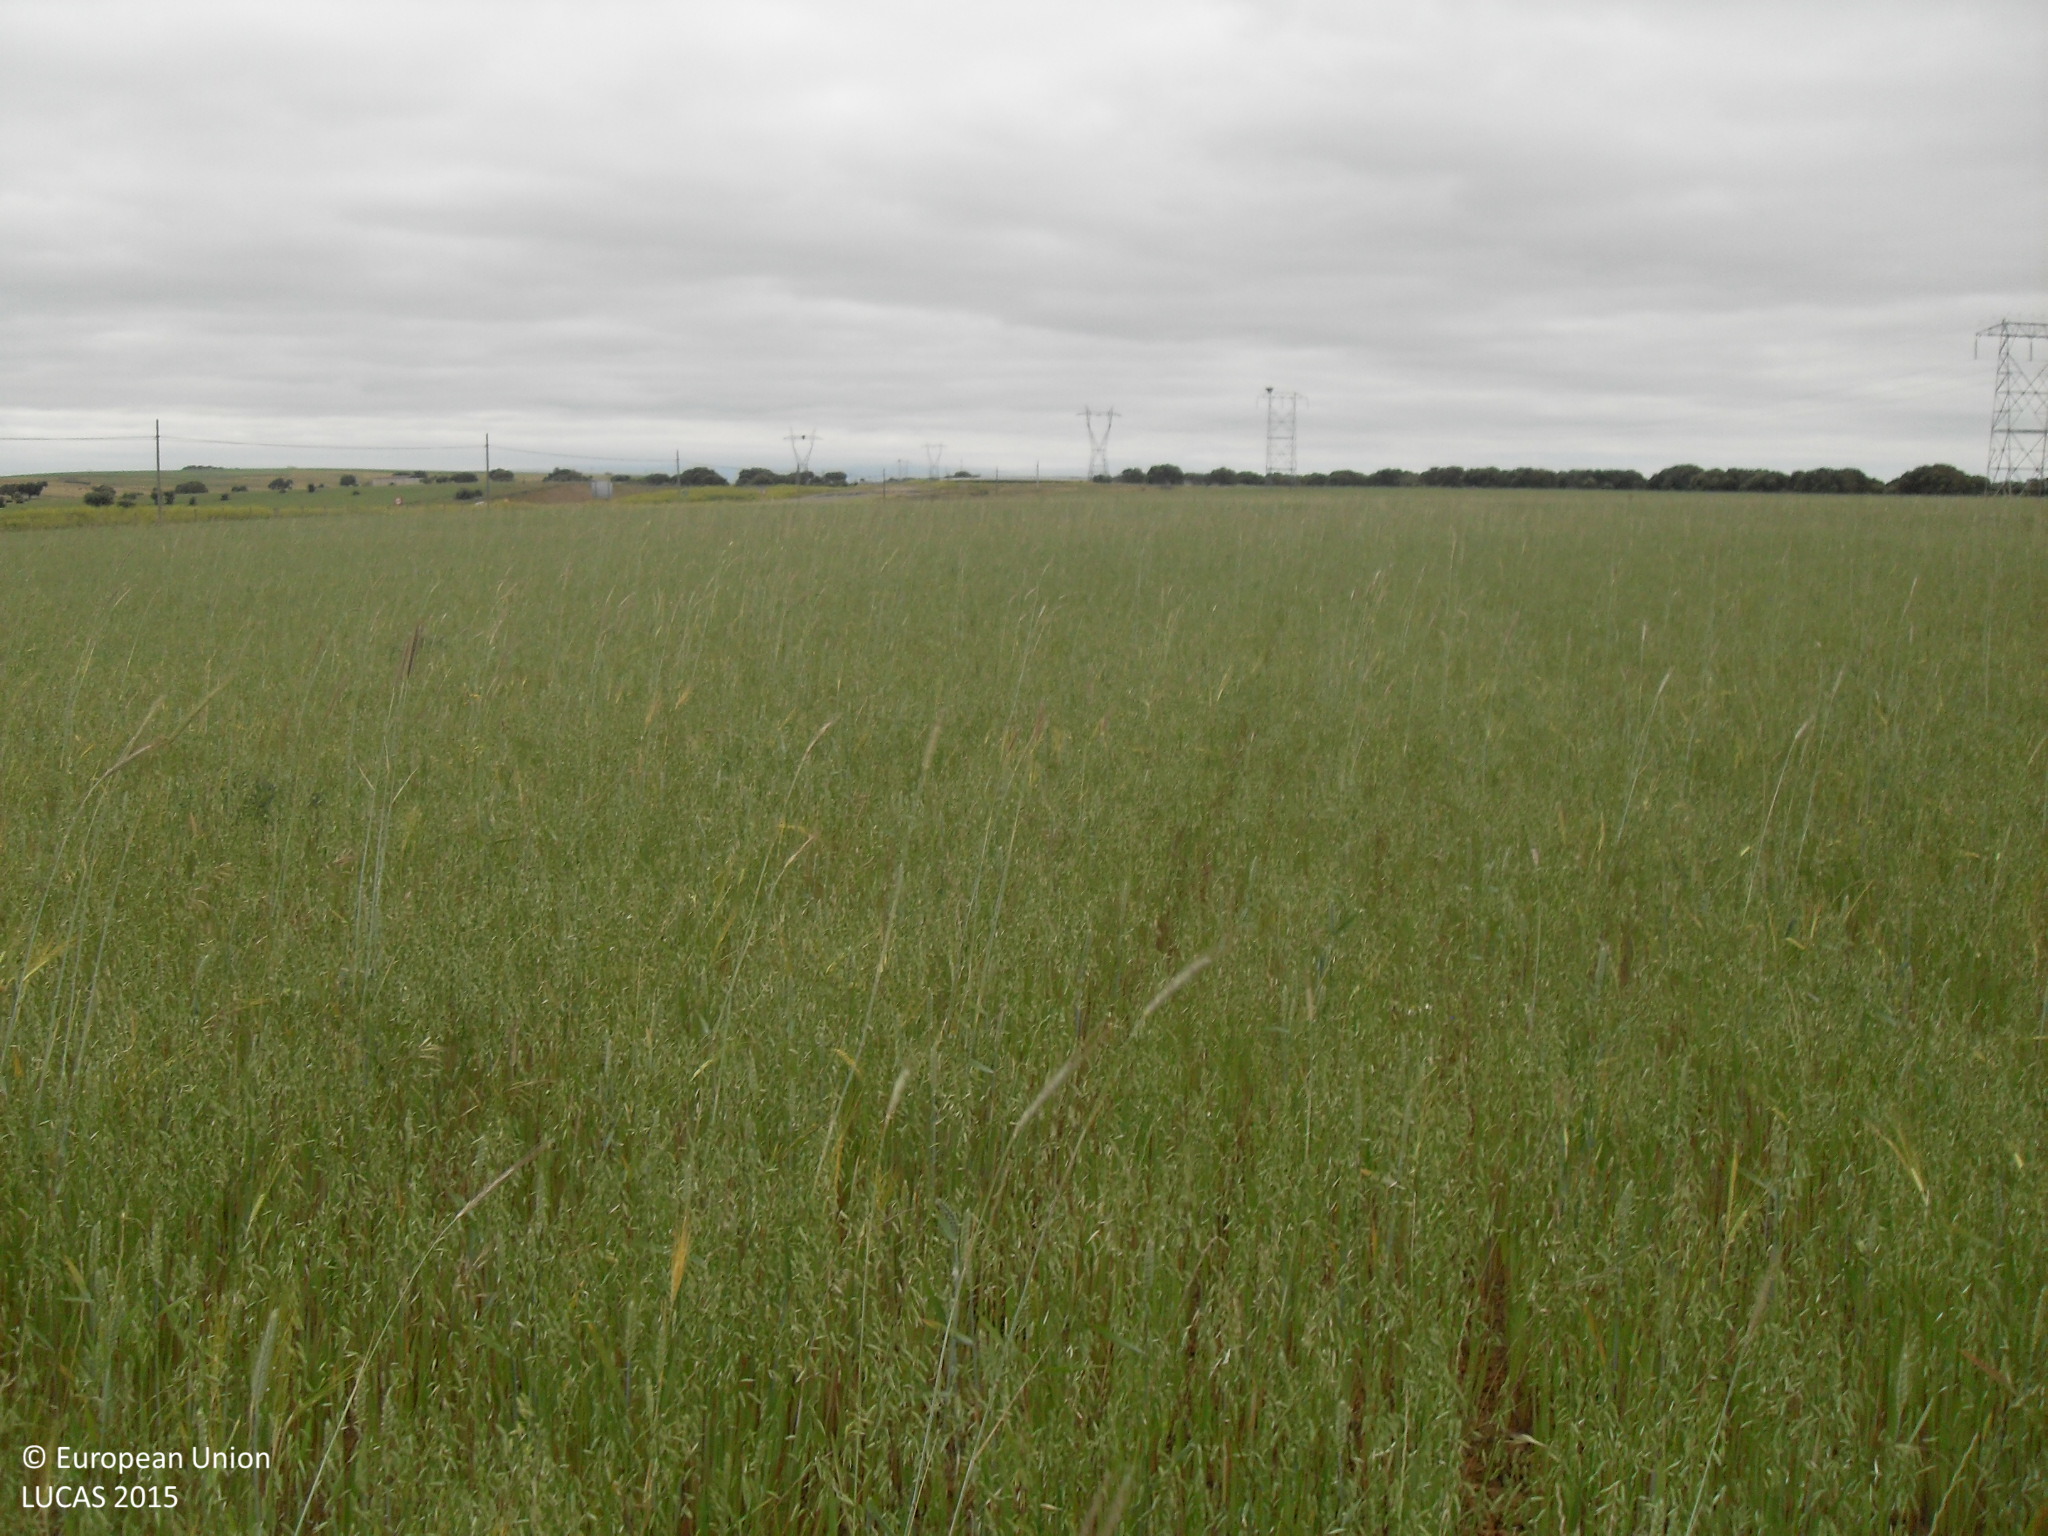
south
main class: Cropland
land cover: Oats
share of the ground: > 75 %
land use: Agriculture (excluding fallow land and kitchen gardens)
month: May
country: ES
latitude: 40.6610
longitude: -5.6260
